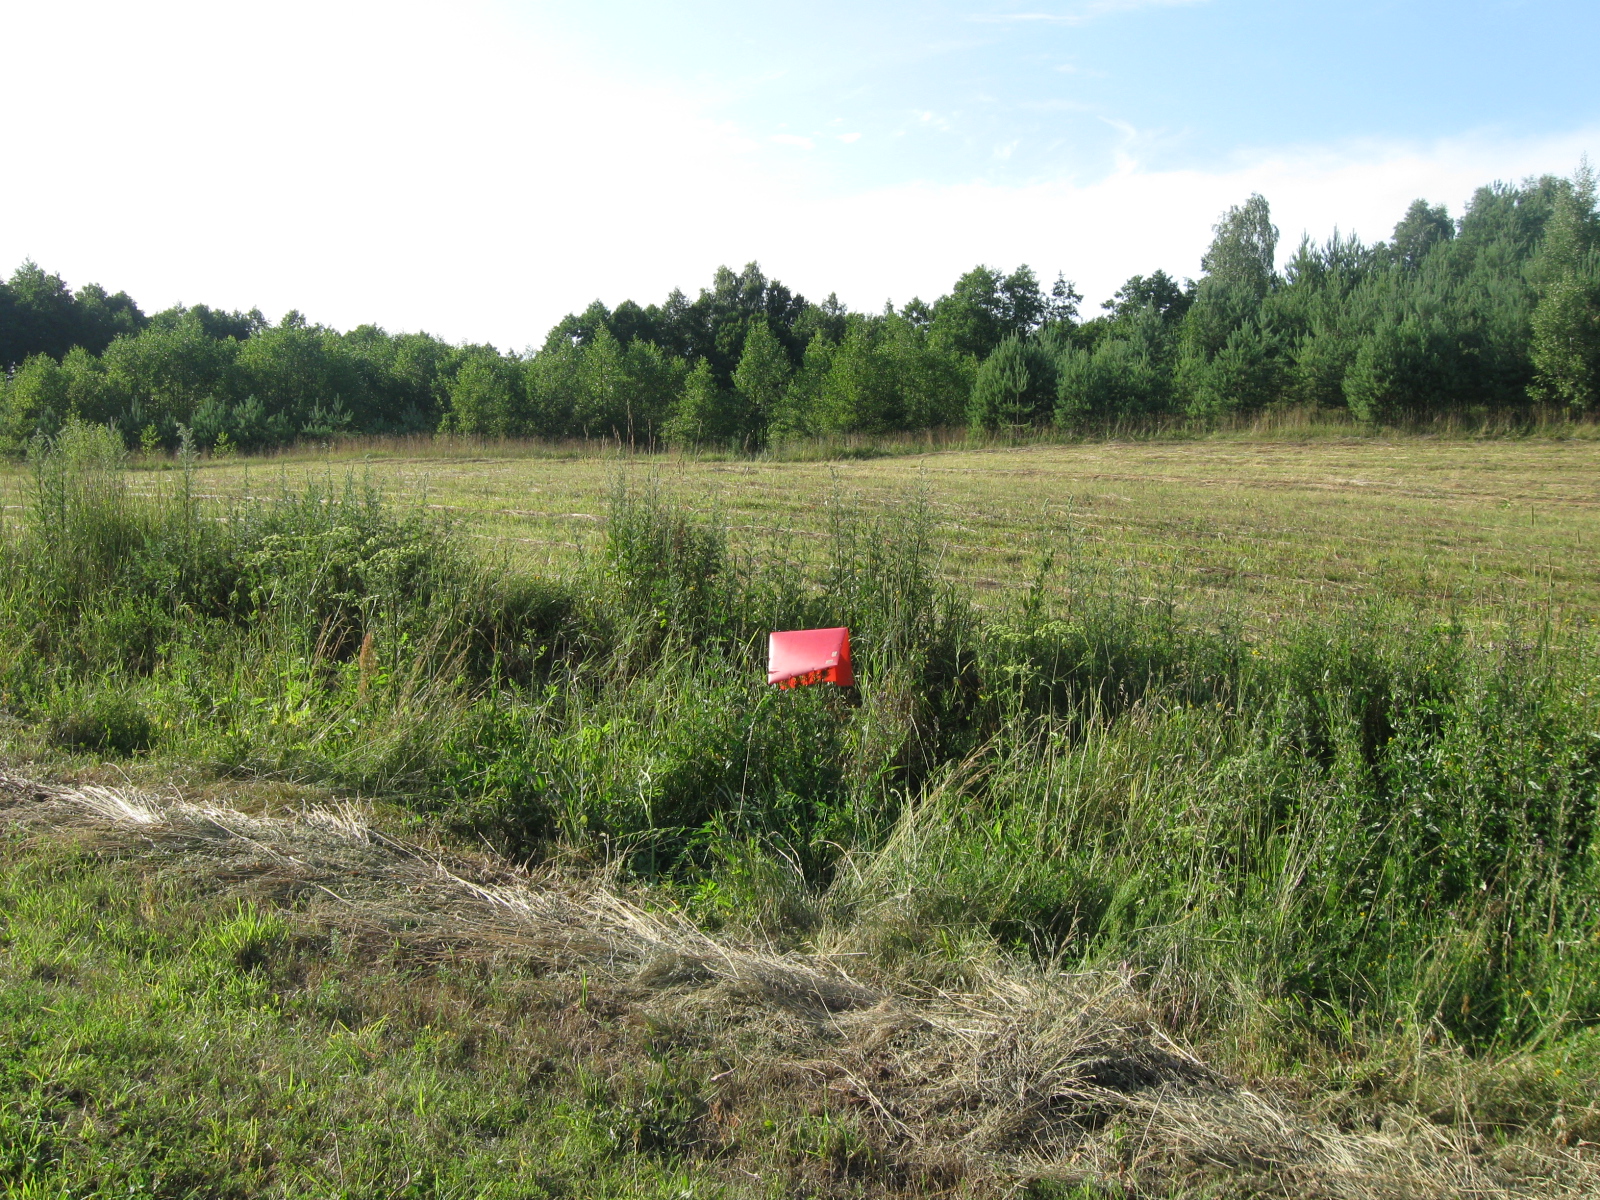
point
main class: Grassland
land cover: Spontaneously vegetated surfaces
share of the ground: > 75 %
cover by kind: herbaceous plants 100 %
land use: Agriculture (excluding fallow land and kitchen gardens)
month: July
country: LT
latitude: 54.4549
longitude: 24.3993
